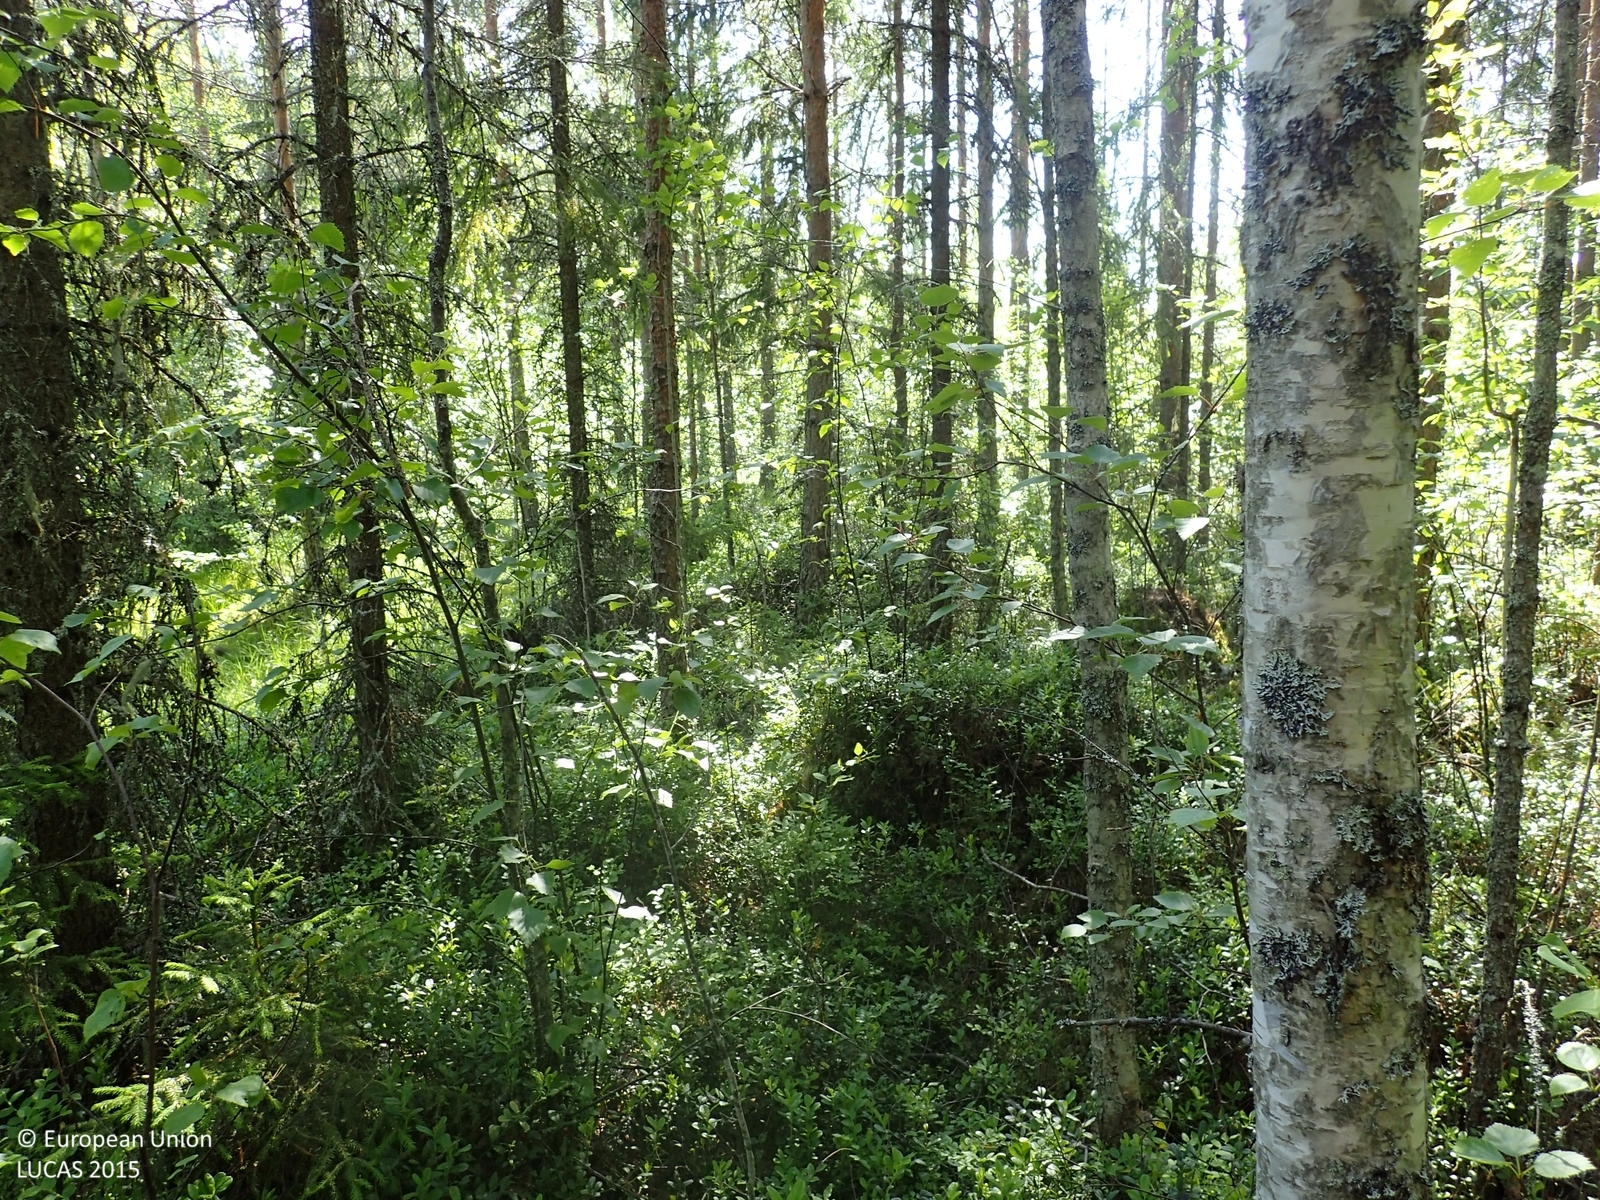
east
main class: Woodland
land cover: Pine dominated coniferous woodland
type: boreal forest
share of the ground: 50 - 75 %
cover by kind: coniferous forest trees 50 %, shrubs 40 %, broadleaved forest trees 10 %
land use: Forestry
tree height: > 5 m
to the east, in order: Pine dominated coniferous woodland; Pine dominated mixed woodland; Pine dominated coniferous woodland; Ditches and canals; Pine dominated coniferous woodland; Ditches and canals; Spruce dominated mixed woodland
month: July
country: FI
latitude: 62.6987
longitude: 21.5135
